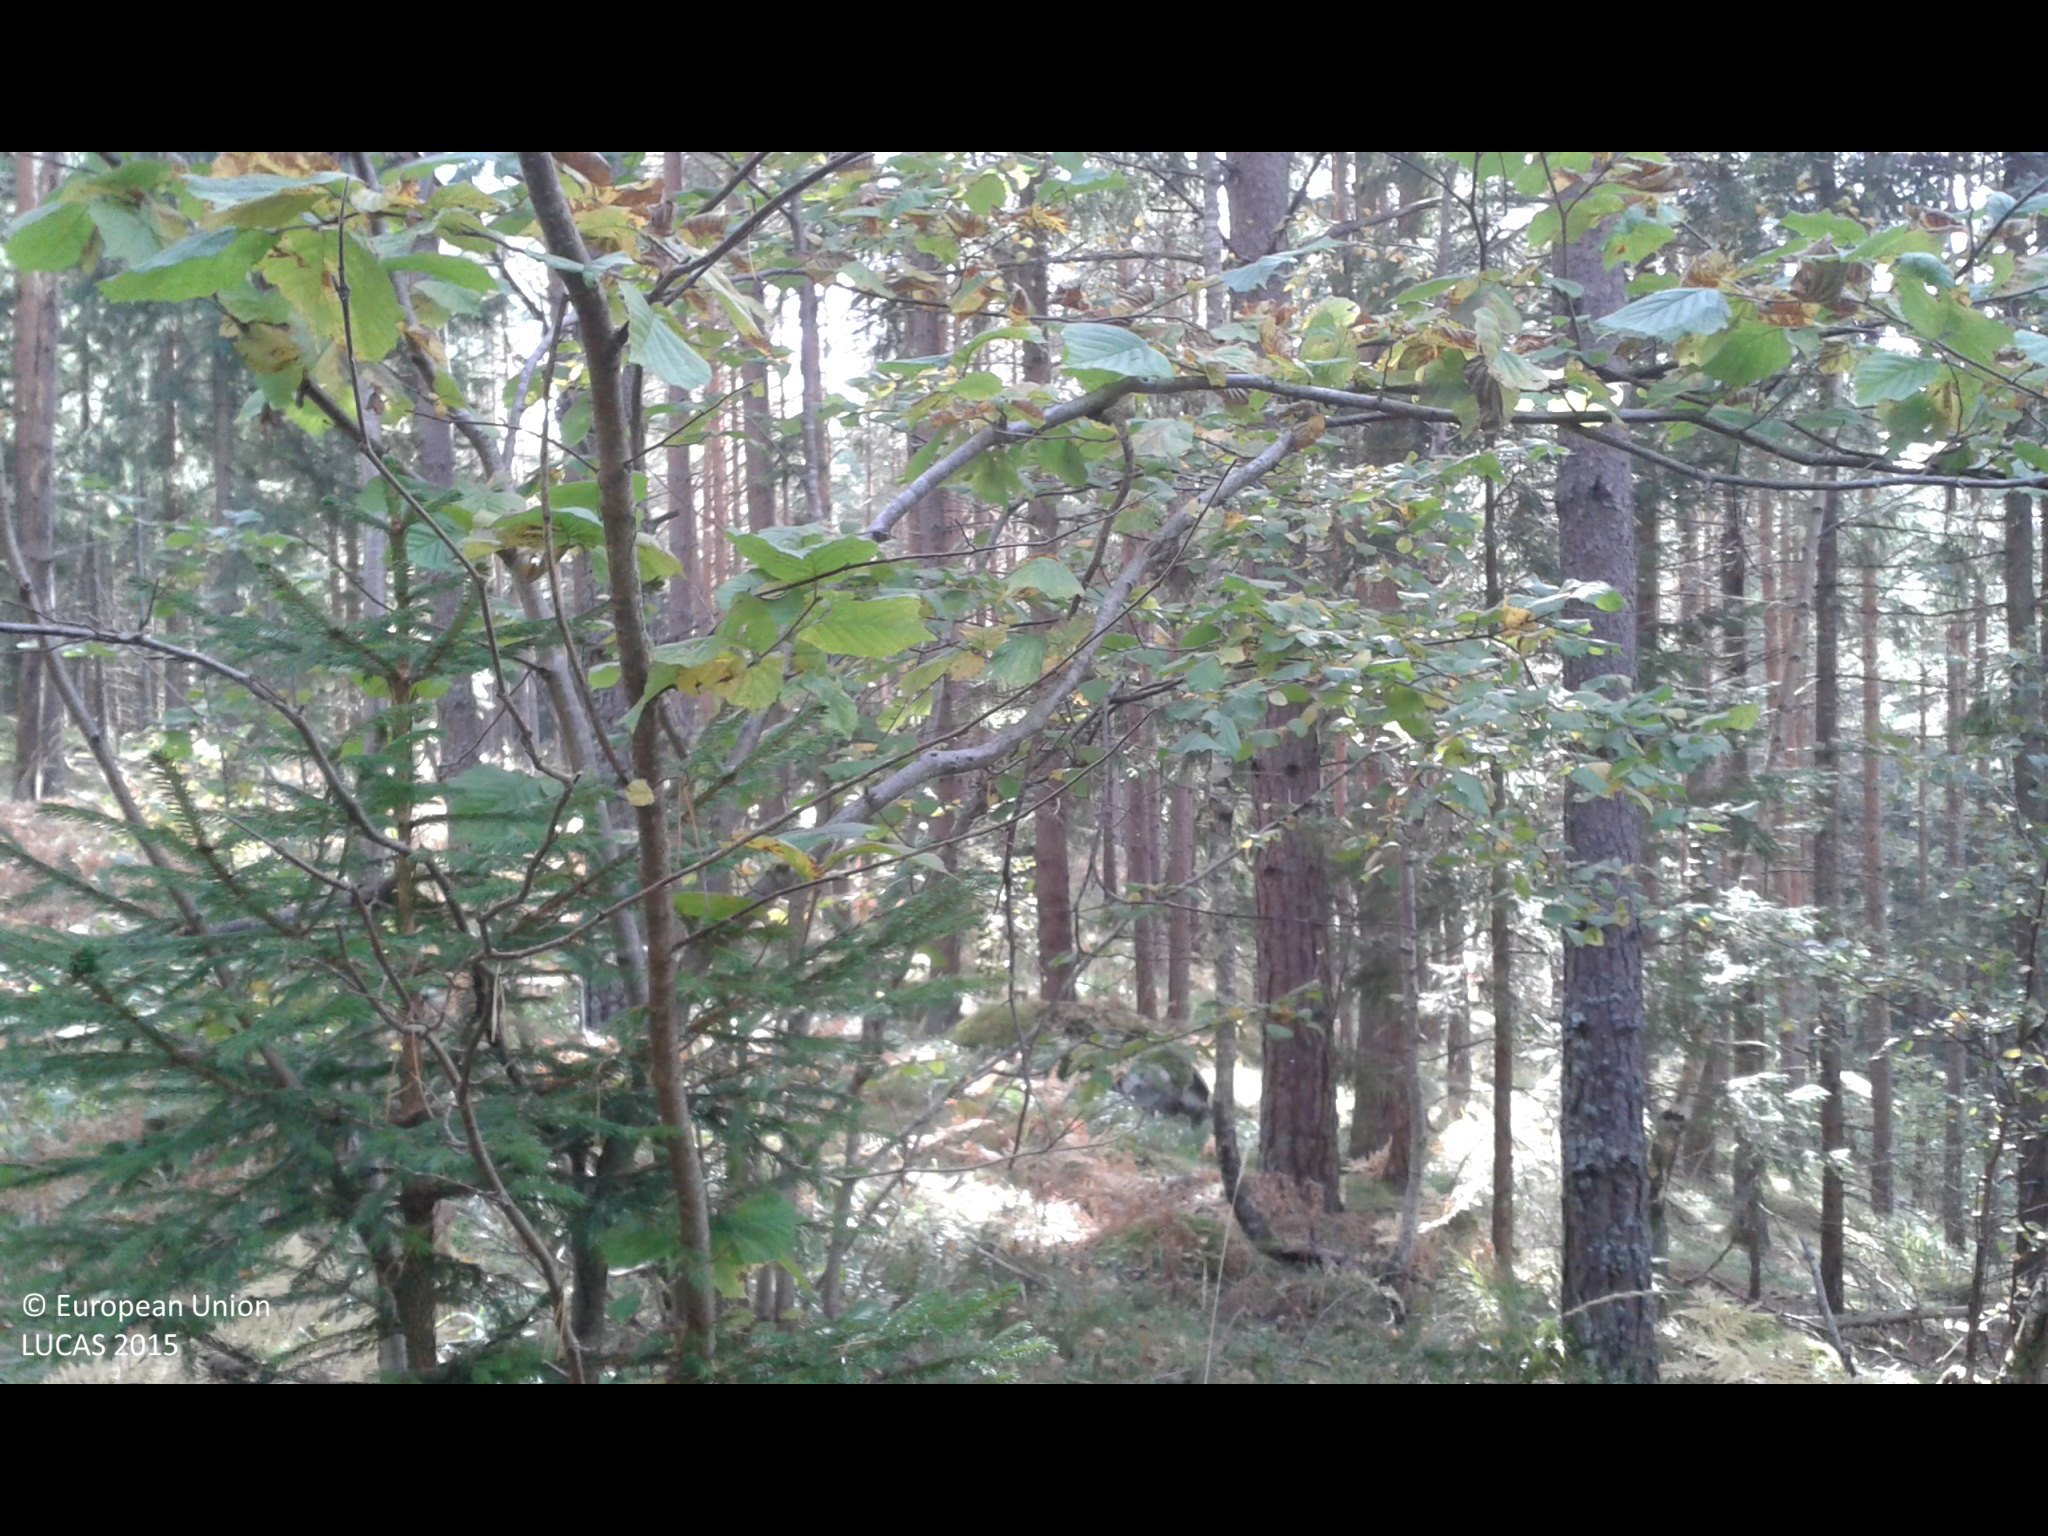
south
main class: Woodland
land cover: Pine dominated coniferous woodland
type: boreal forest
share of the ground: 50 - 75 %
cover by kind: coniferous forest trees 55 %, herbaceous plants 40 %, broadleaved forest trees 5 %
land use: Forestry
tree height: > 5 m
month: October
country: SE
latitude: 58.9223
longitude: 17.3441
